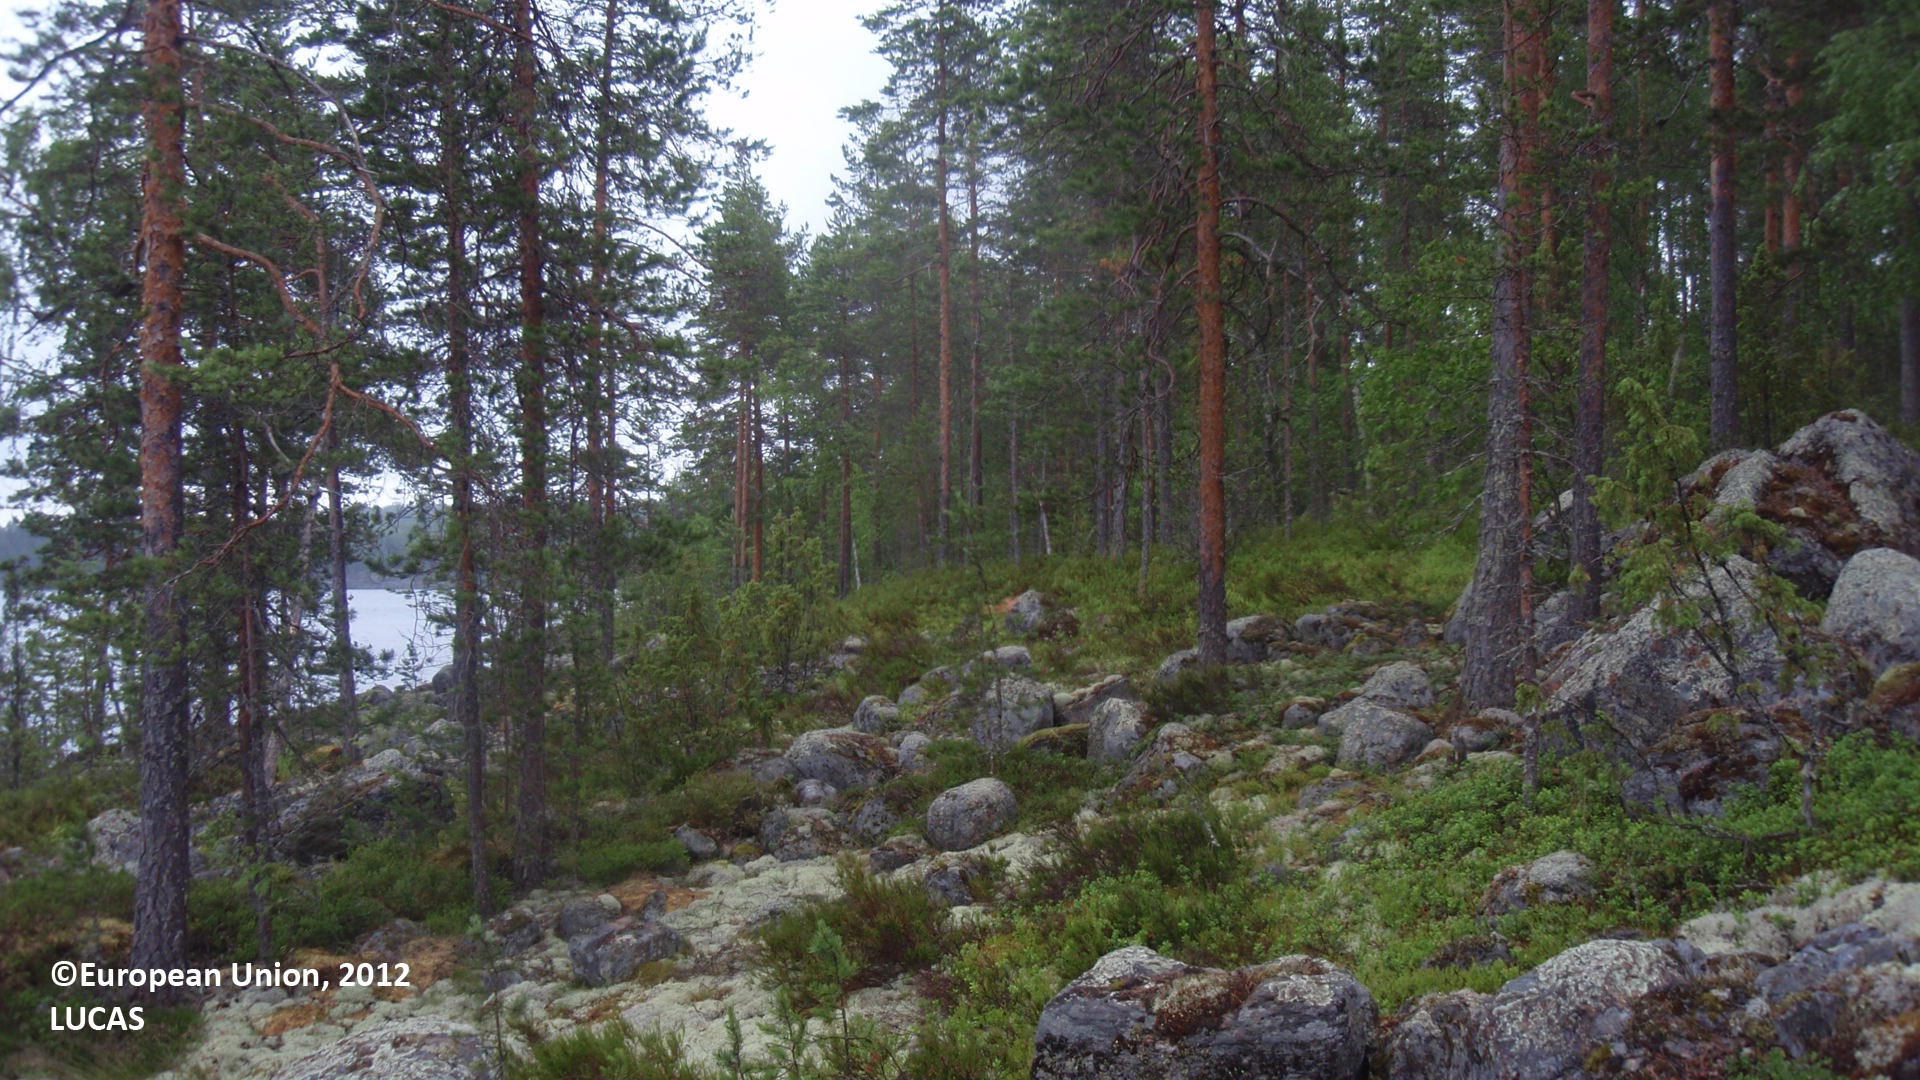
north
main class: Woodland
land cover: Pine dominated coniferous woodland
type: boreal forest
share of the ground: 25 - 50 %
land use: Forestry
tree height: > 5 m
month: July
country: FI
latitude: 61.5066
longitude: 28.3391
